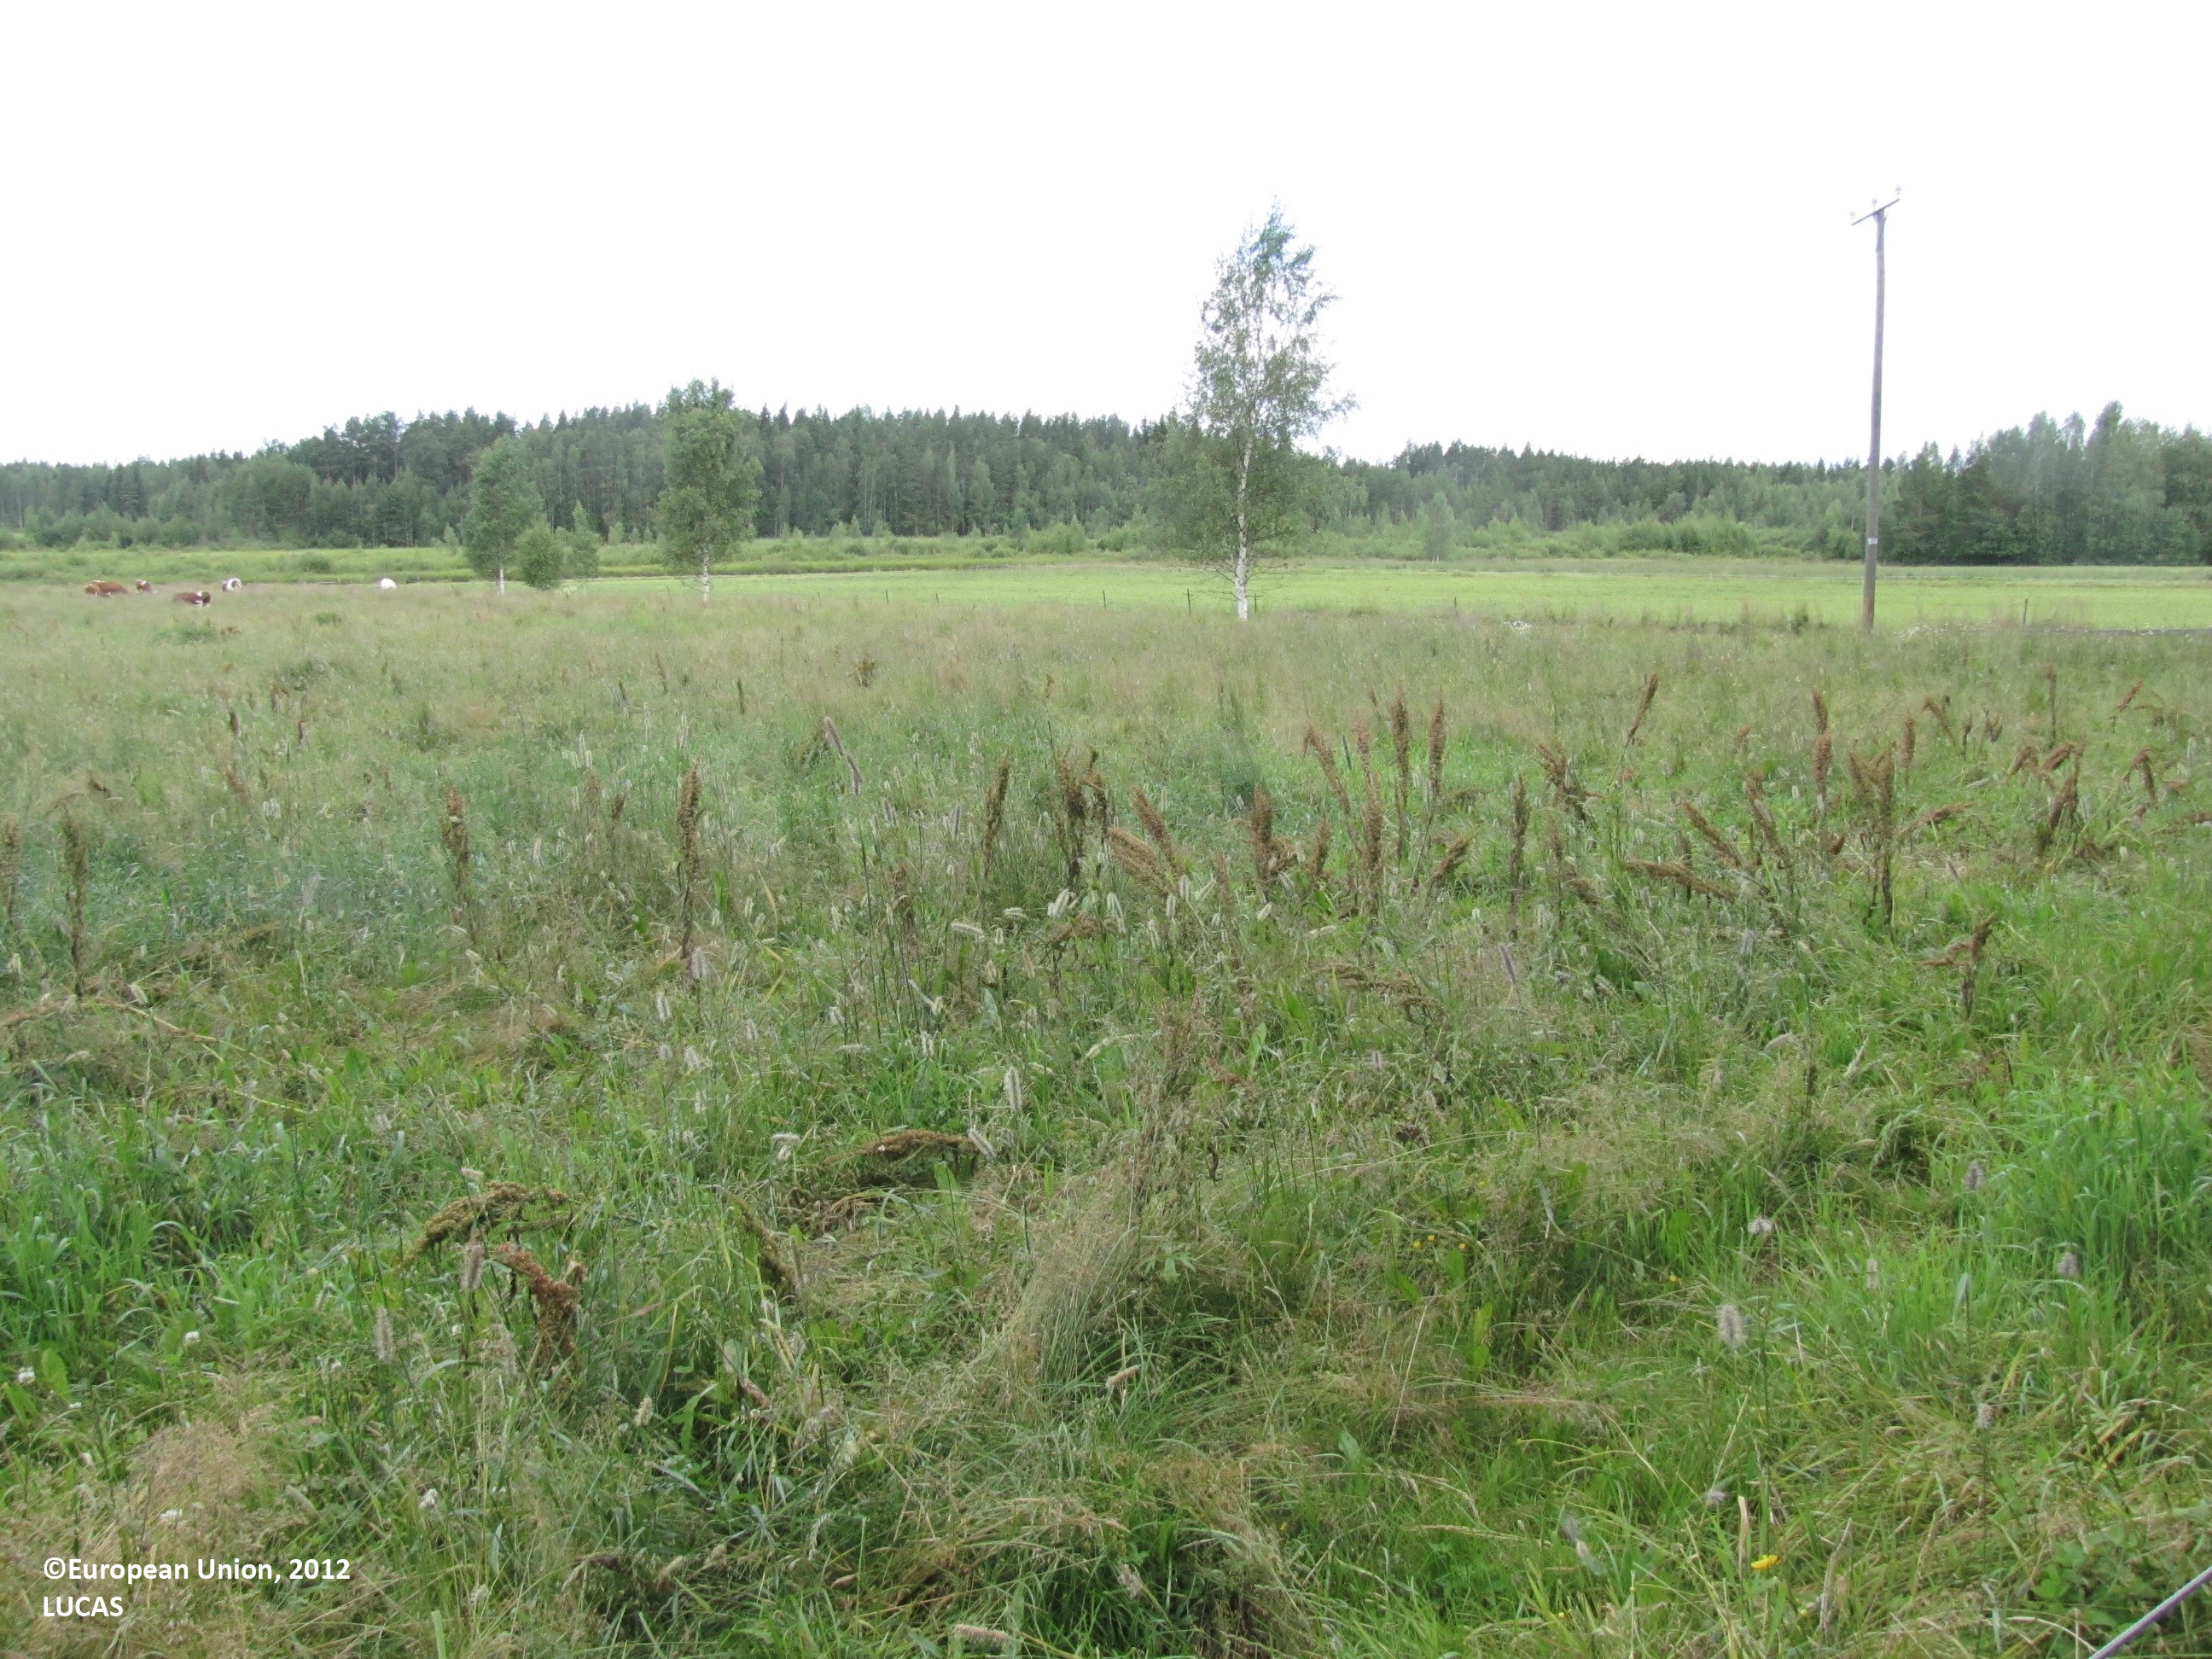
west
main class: Grassland
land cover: Grassland without tree/shrub cover
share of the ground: > 75 %
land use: Agriculture (excluding fallow land and kitchen gardens)
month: July
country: FI
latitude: 62.6204
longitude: 23.3409
